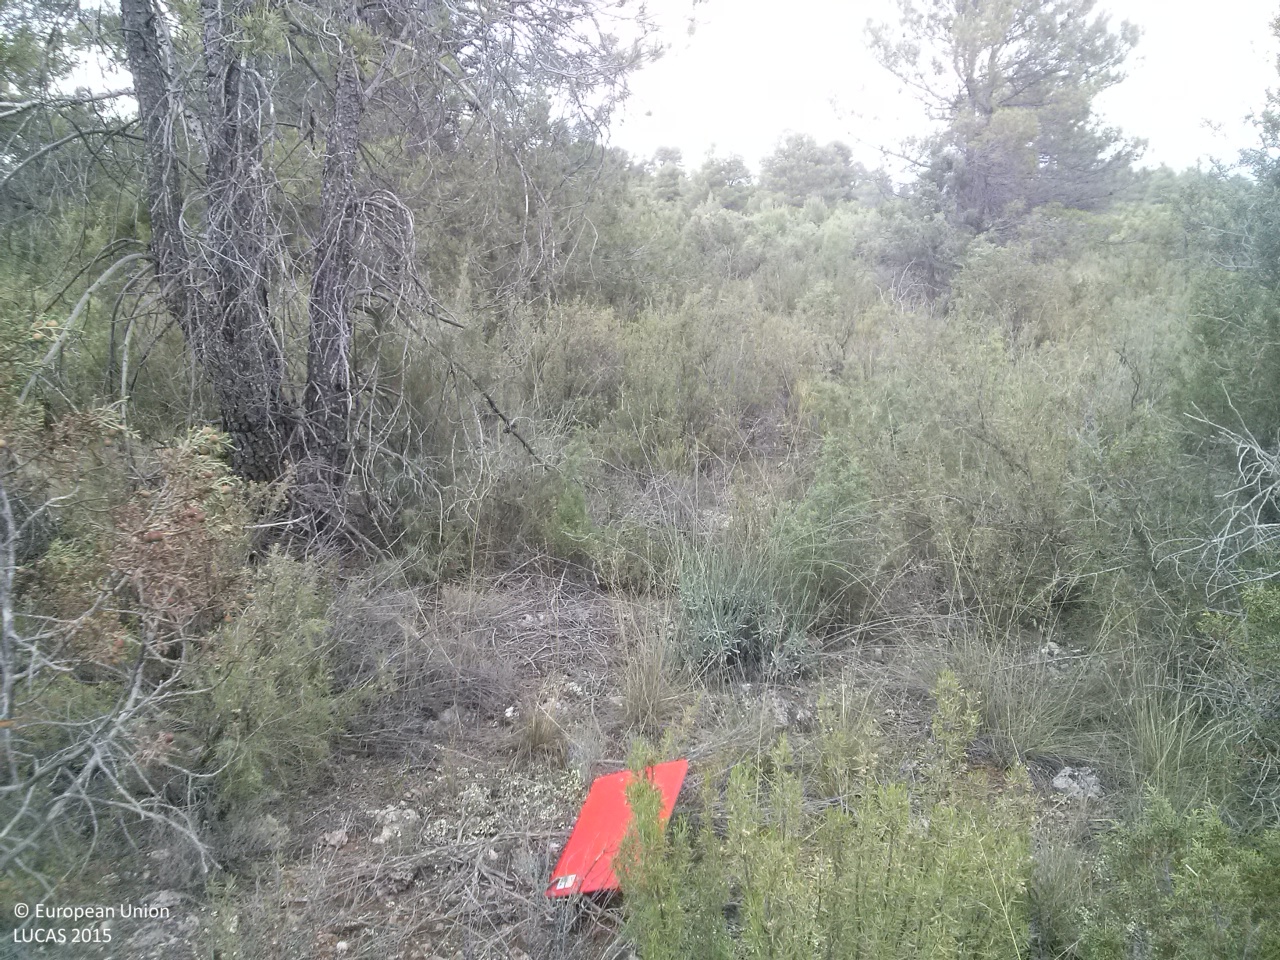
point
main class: Woodland
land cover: Pine dominated coniferous woodland
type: coniferous forest of the mediterranean region
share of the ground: 10 - 25 %
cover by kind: shrubs 50 %, coniferous forest trees 25 %, herbaceous plants 25 %
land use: Forestry
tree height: > 5 m
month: June
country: ES
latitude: 39.7580
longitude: -1.7629
